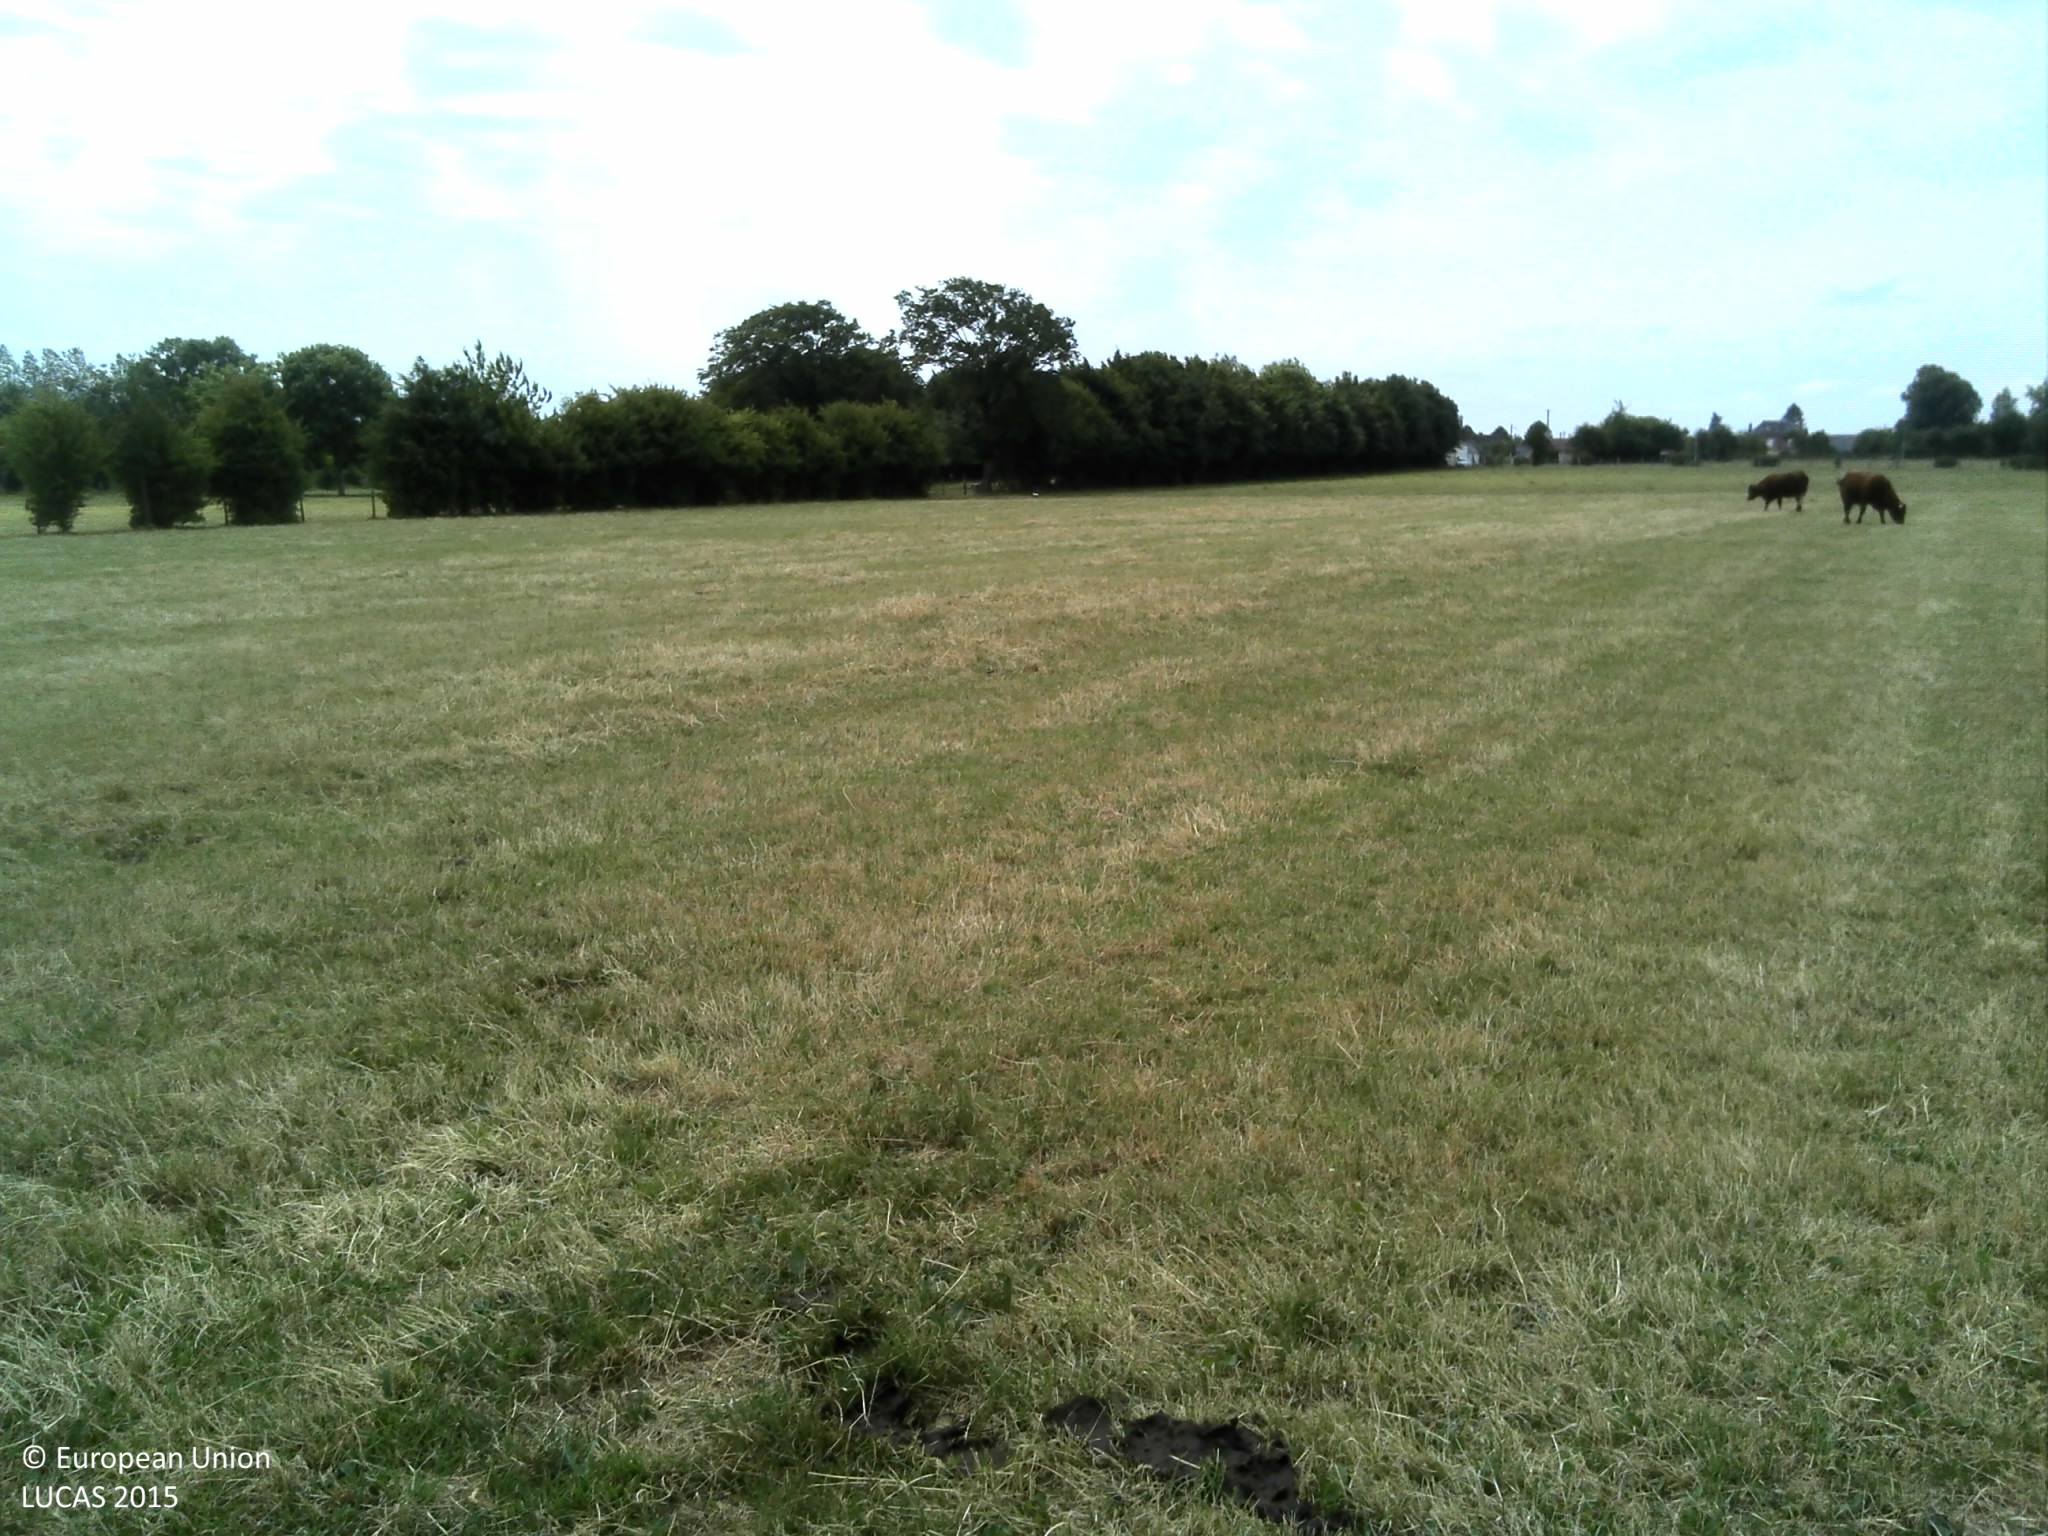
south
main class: Grassland
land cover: Grassland without tree/shrub cover
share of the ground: > 75 %
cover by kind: herbaceous plants 100 %
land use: Agriculture (excluding fallow land and kitchen gardens)
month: July
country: FR
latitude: 49.8575
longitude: 1.6222
